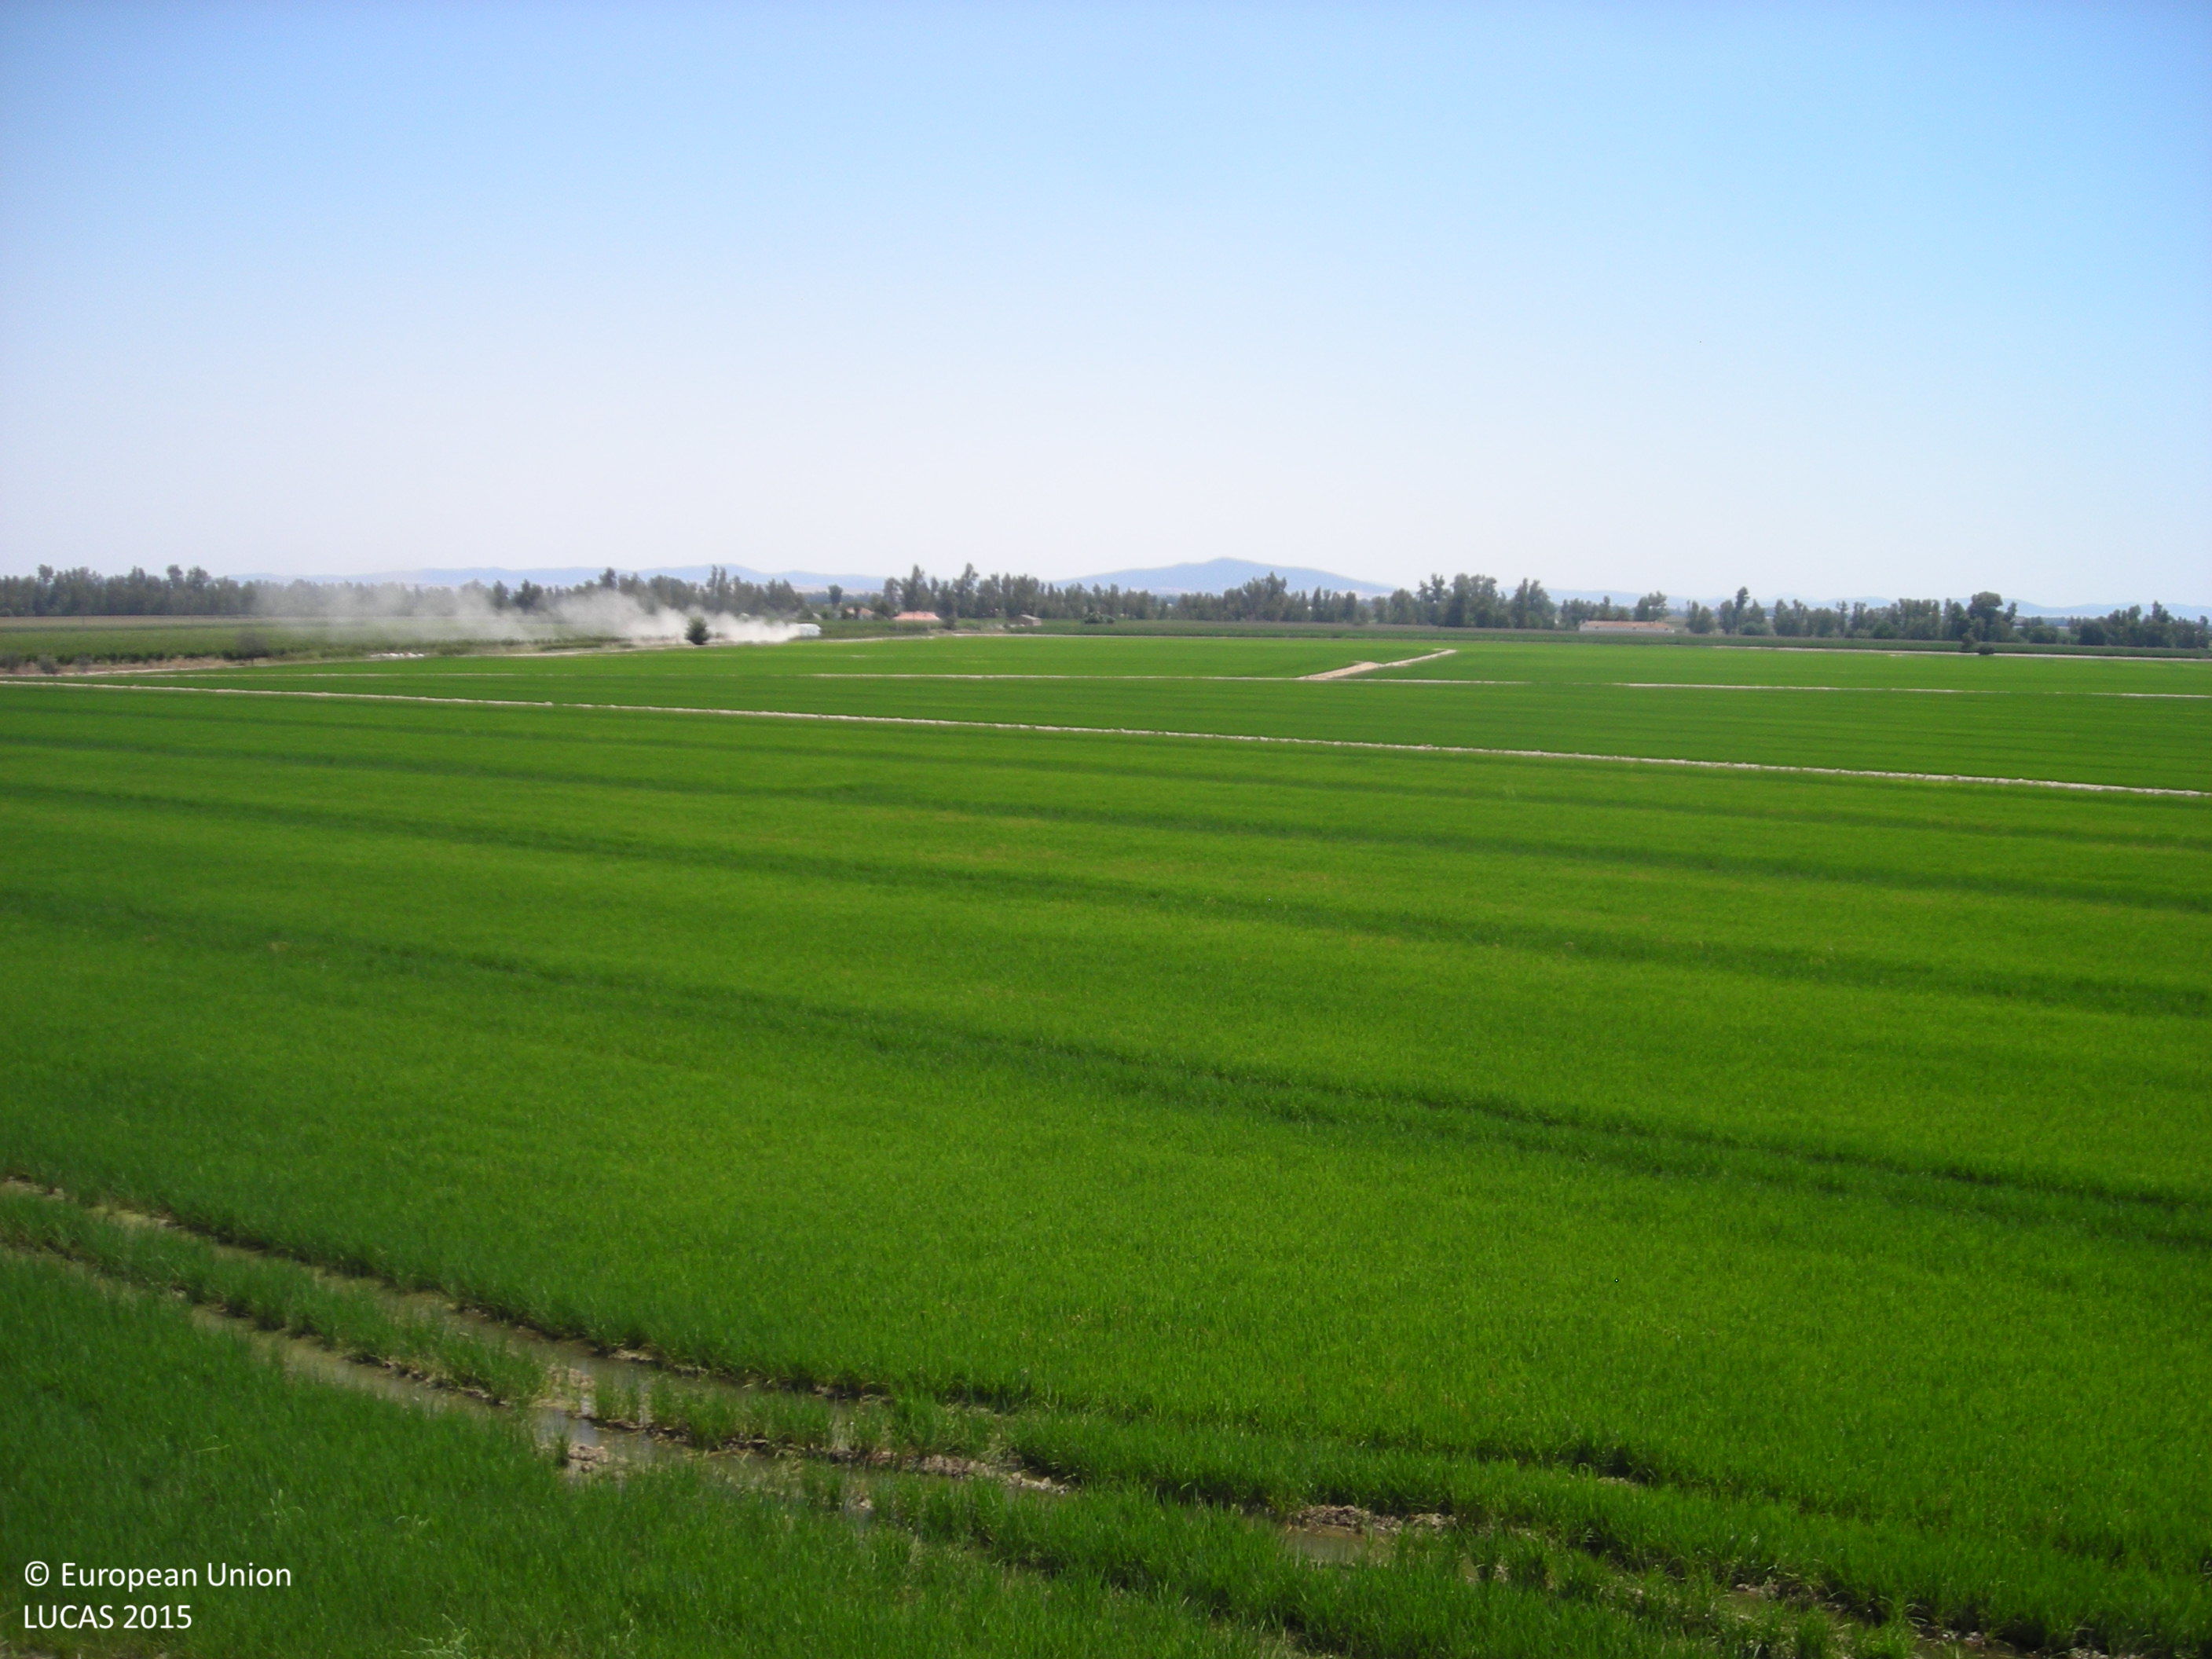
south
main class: Cropland
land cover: Rice
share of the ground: > 75 %
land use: Agriculture (excluding fallow land and kitchen gardens)
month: July
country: ES
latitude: 39.0618
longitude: -5.8490
